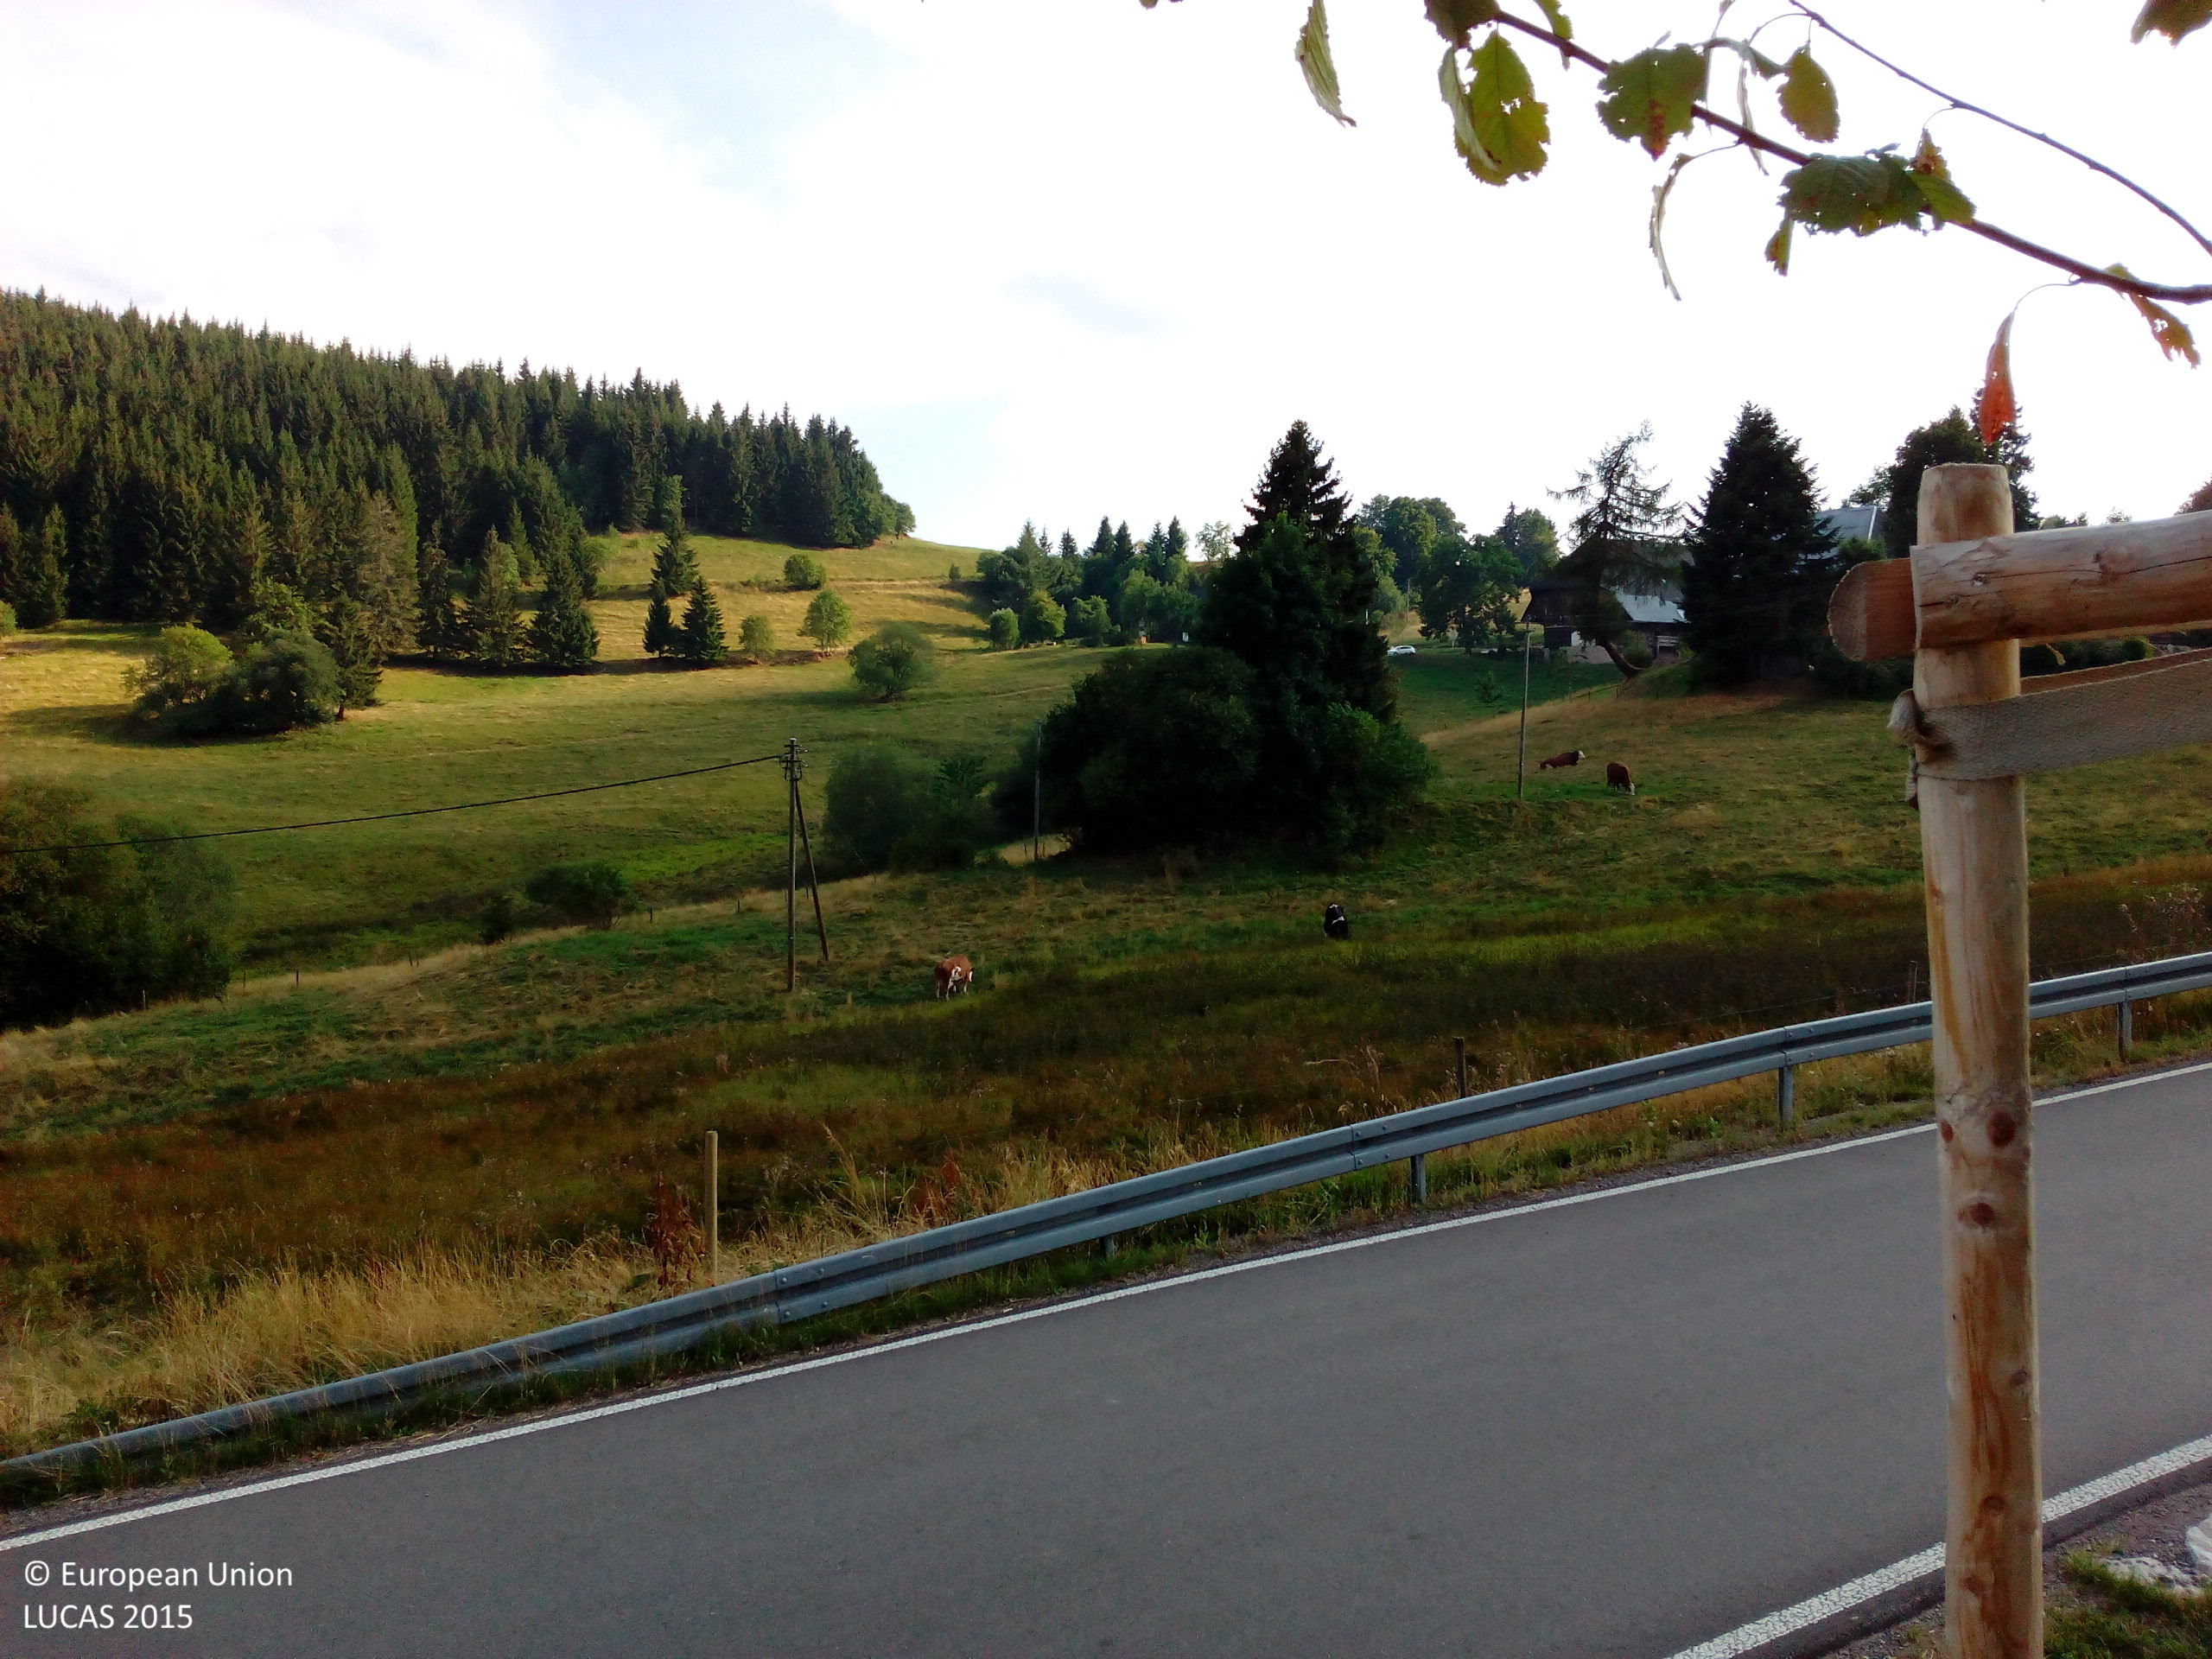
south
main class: Grassland
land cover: Grassland without tree/shrub cover
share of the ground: > 75 %
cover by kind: herbaceous plants 100 %
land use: Agriculture (excluding fallow land and kitchen gardens)
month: August
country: DE
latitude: 47.8659
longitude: 8.1430
